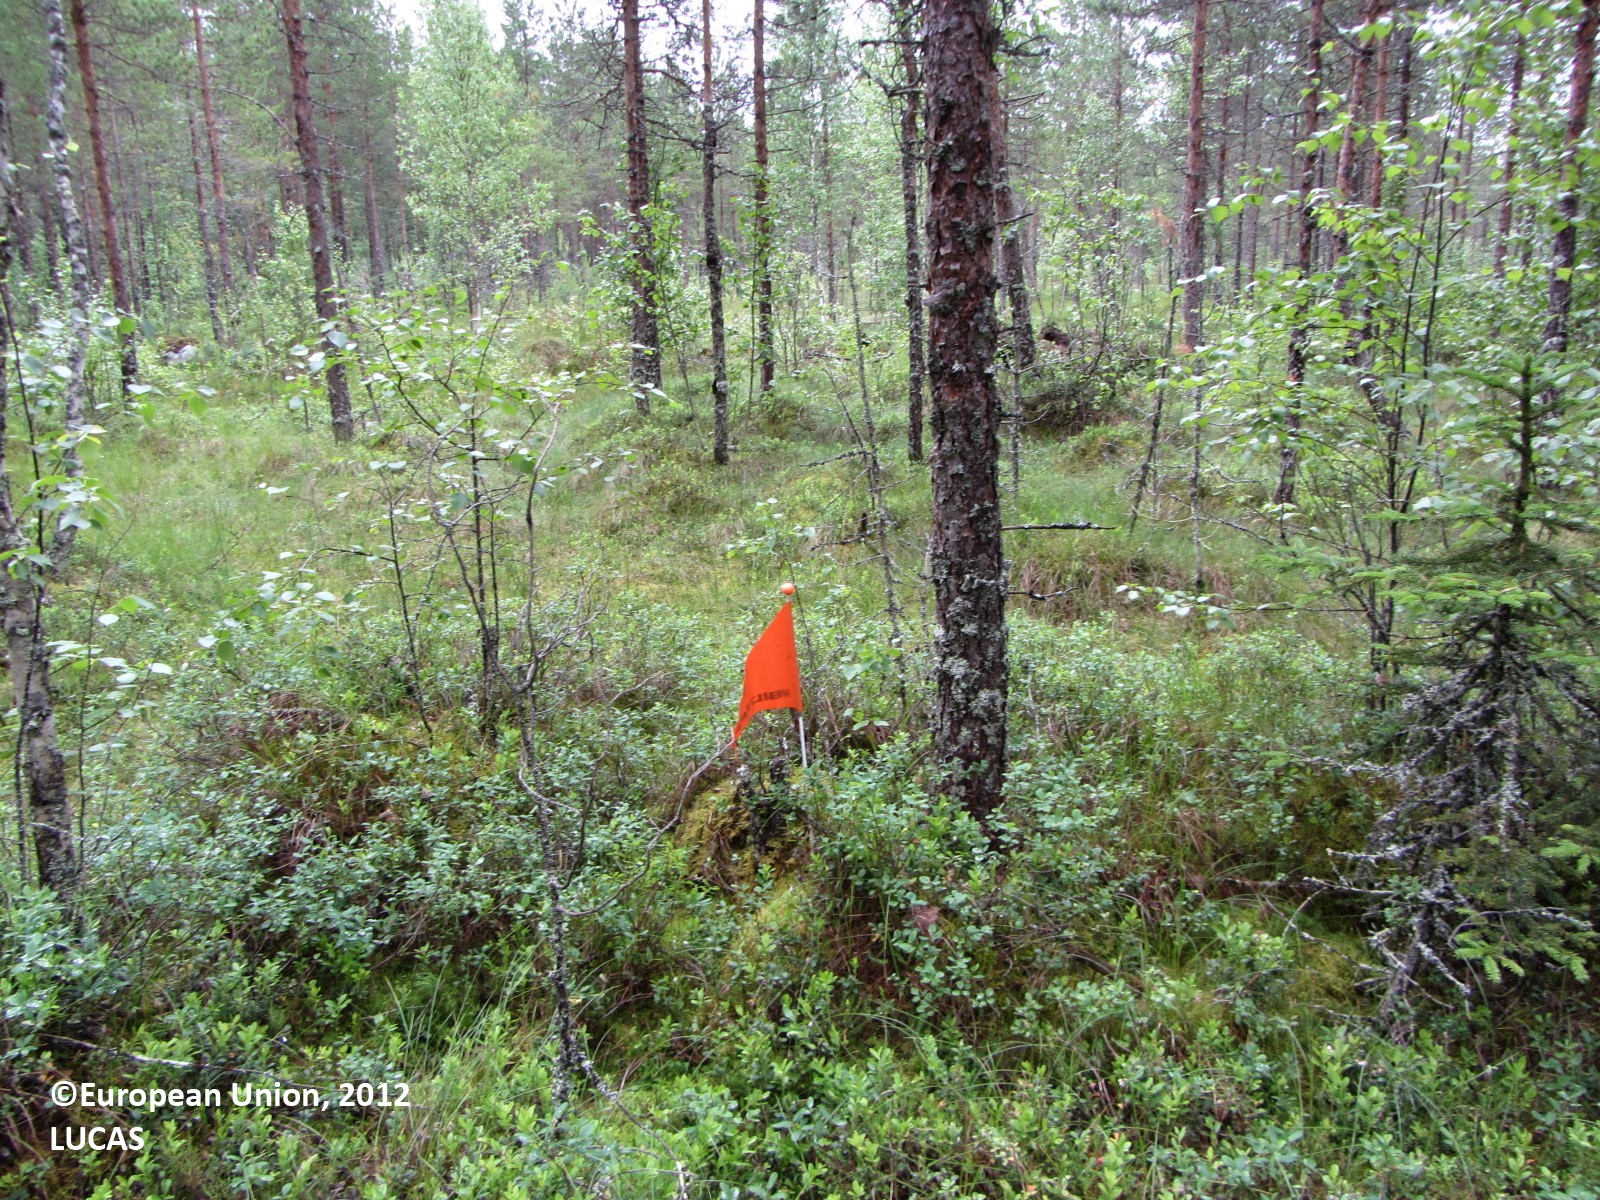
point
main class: Woodland
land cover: Pine dominated coniferous woodland
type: boreal forest
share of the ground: 50 - 75 %
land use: Forestry
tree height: > 5 m
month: July
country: FI
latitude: 63.8577
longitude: 25.6216
